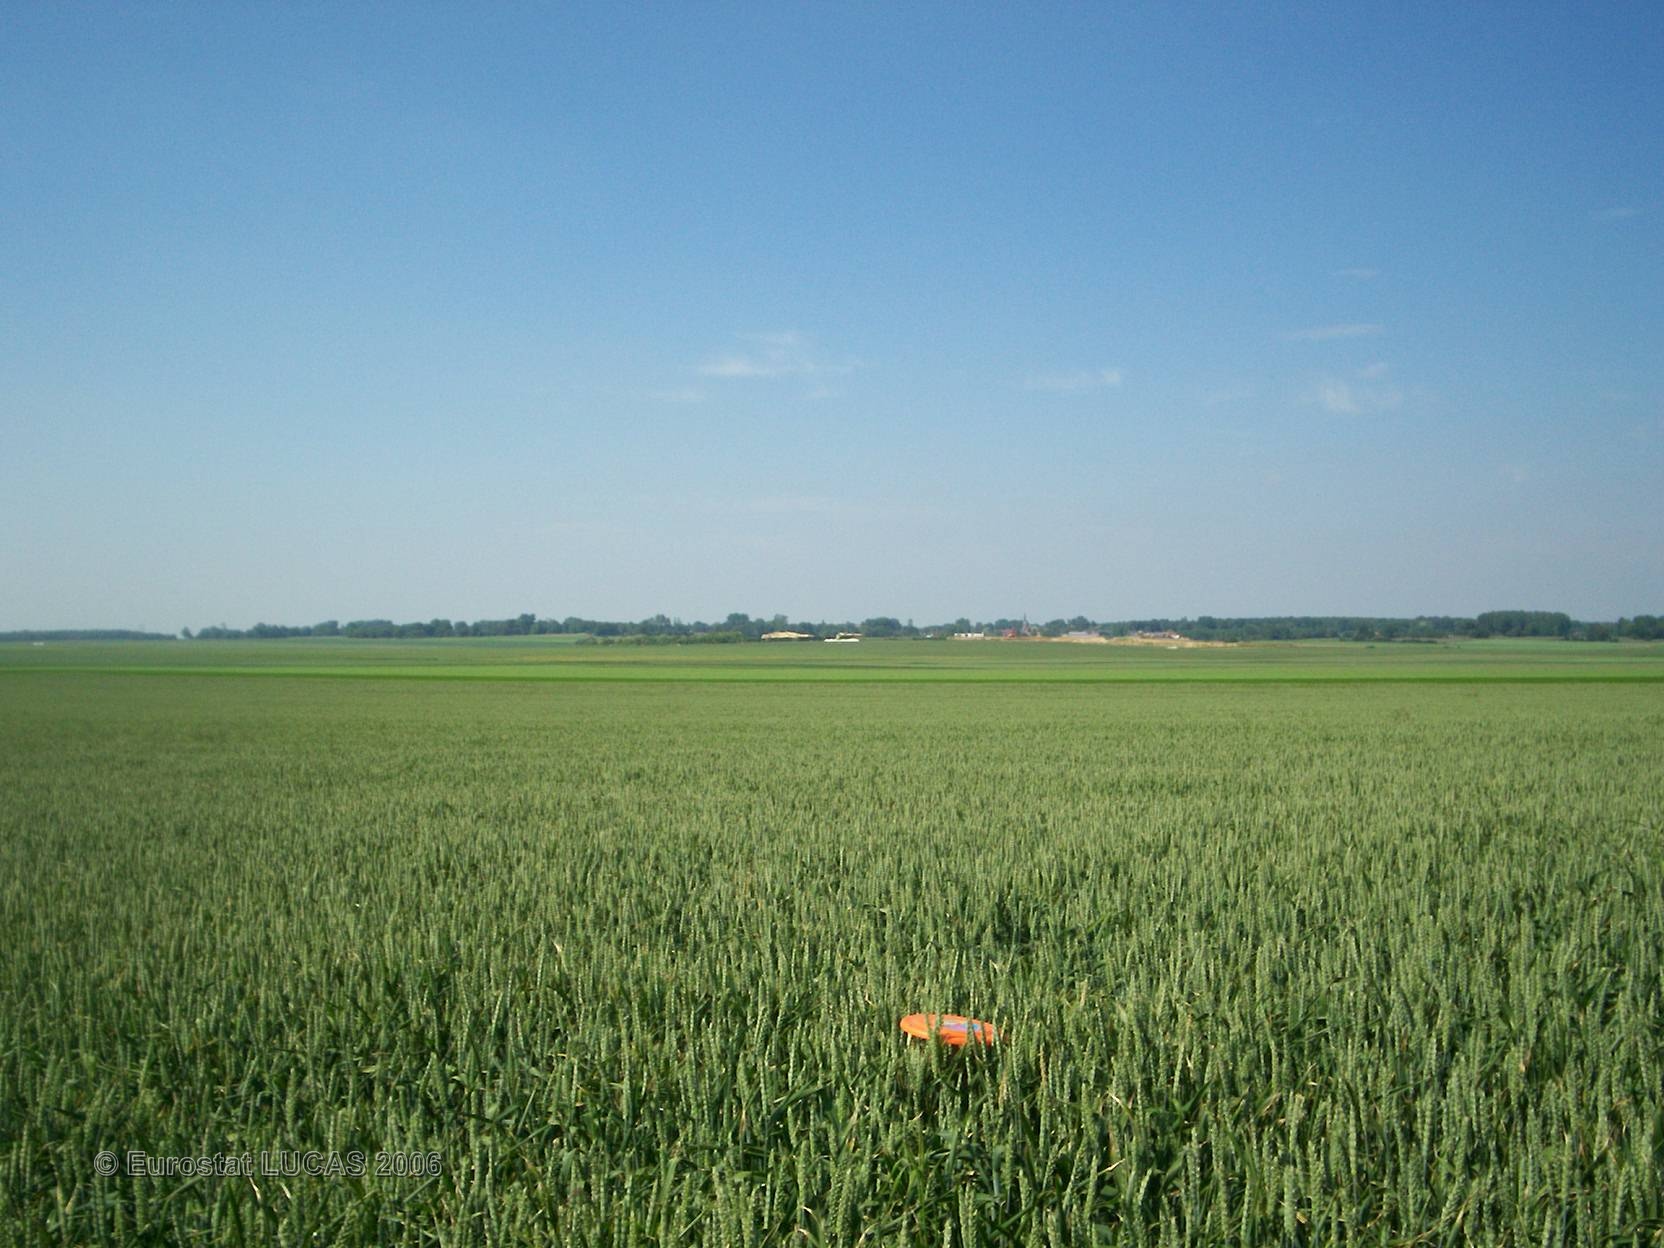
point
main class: Cropland
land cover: Common wheat
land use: Agriculture (excluding fallow land and kitchen gardens)
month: June
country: FR
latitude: 49.5674
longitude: 2.6466
